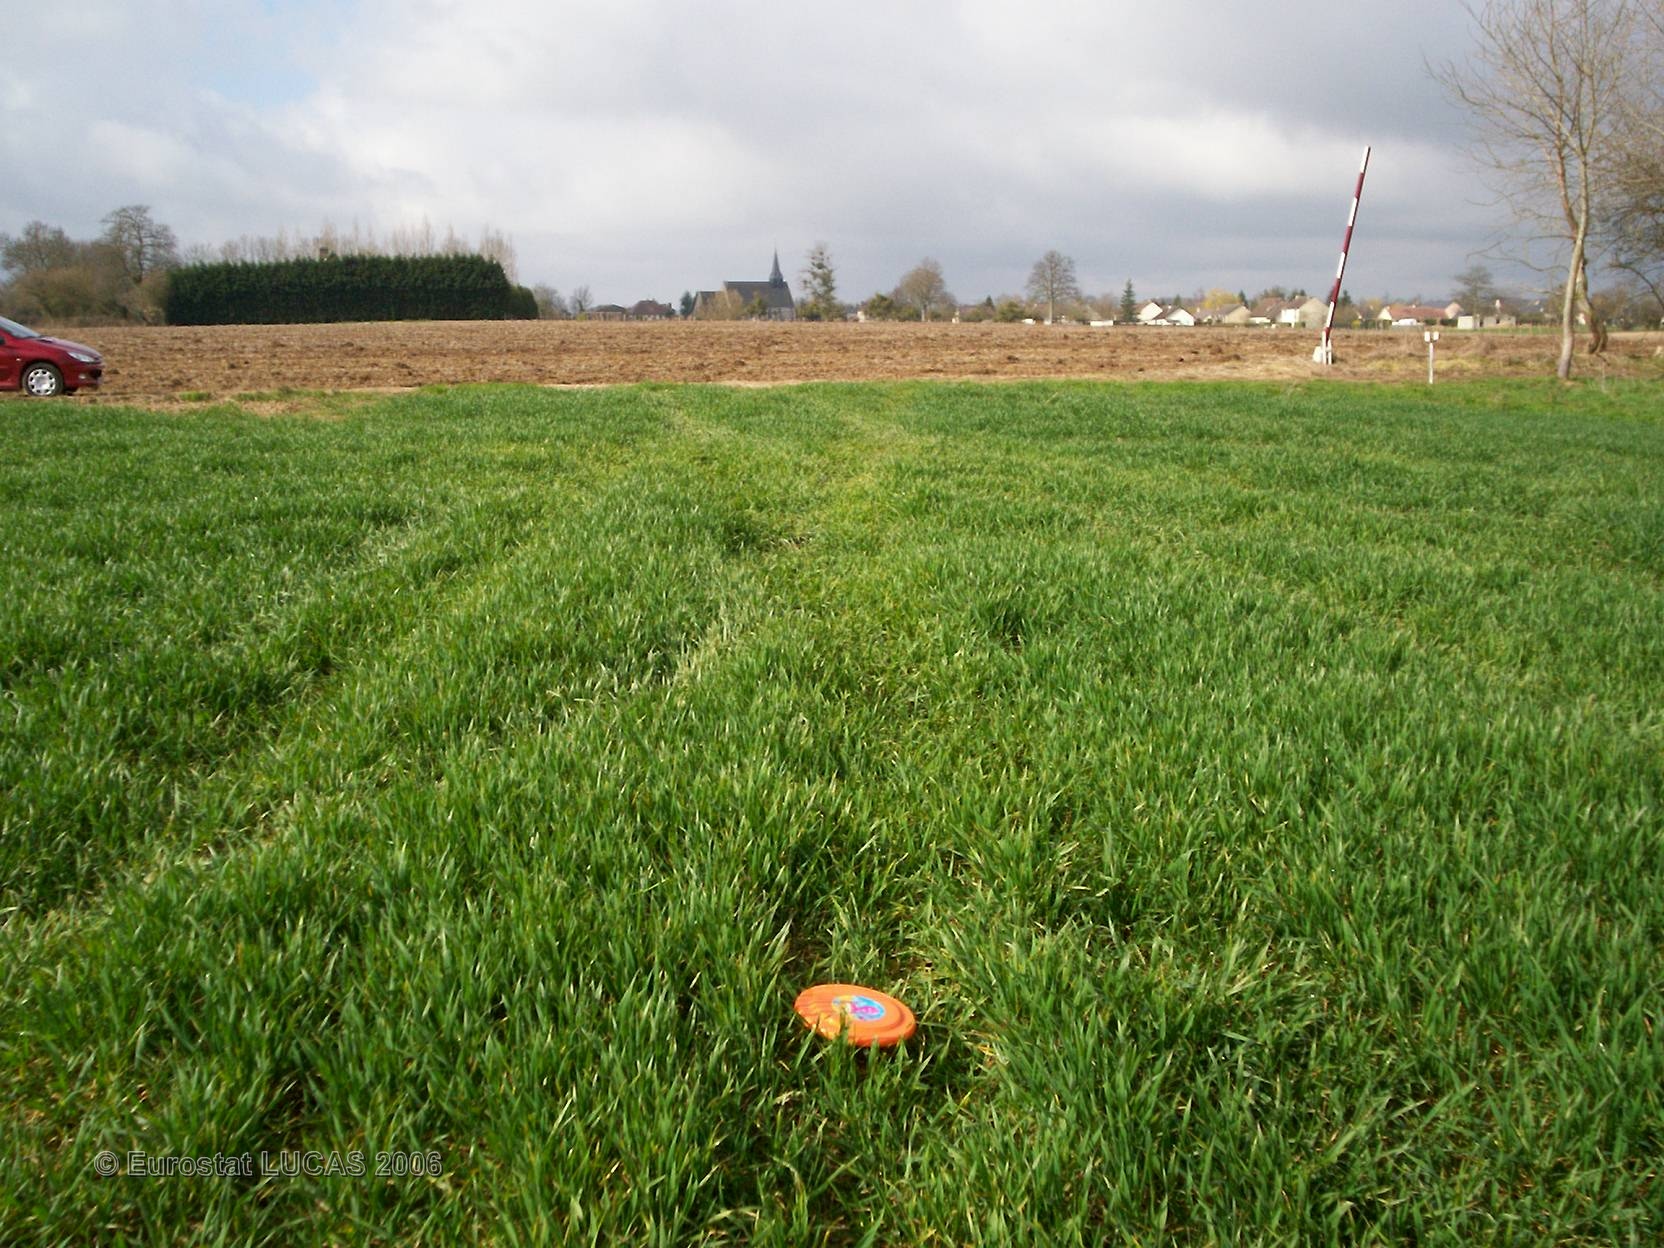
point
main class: Cropland
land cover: Triticale
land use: Agriculture (excluding fallow land and kitchen gardens)
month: April
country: FR
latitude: 48.8321
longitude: 0.5615
